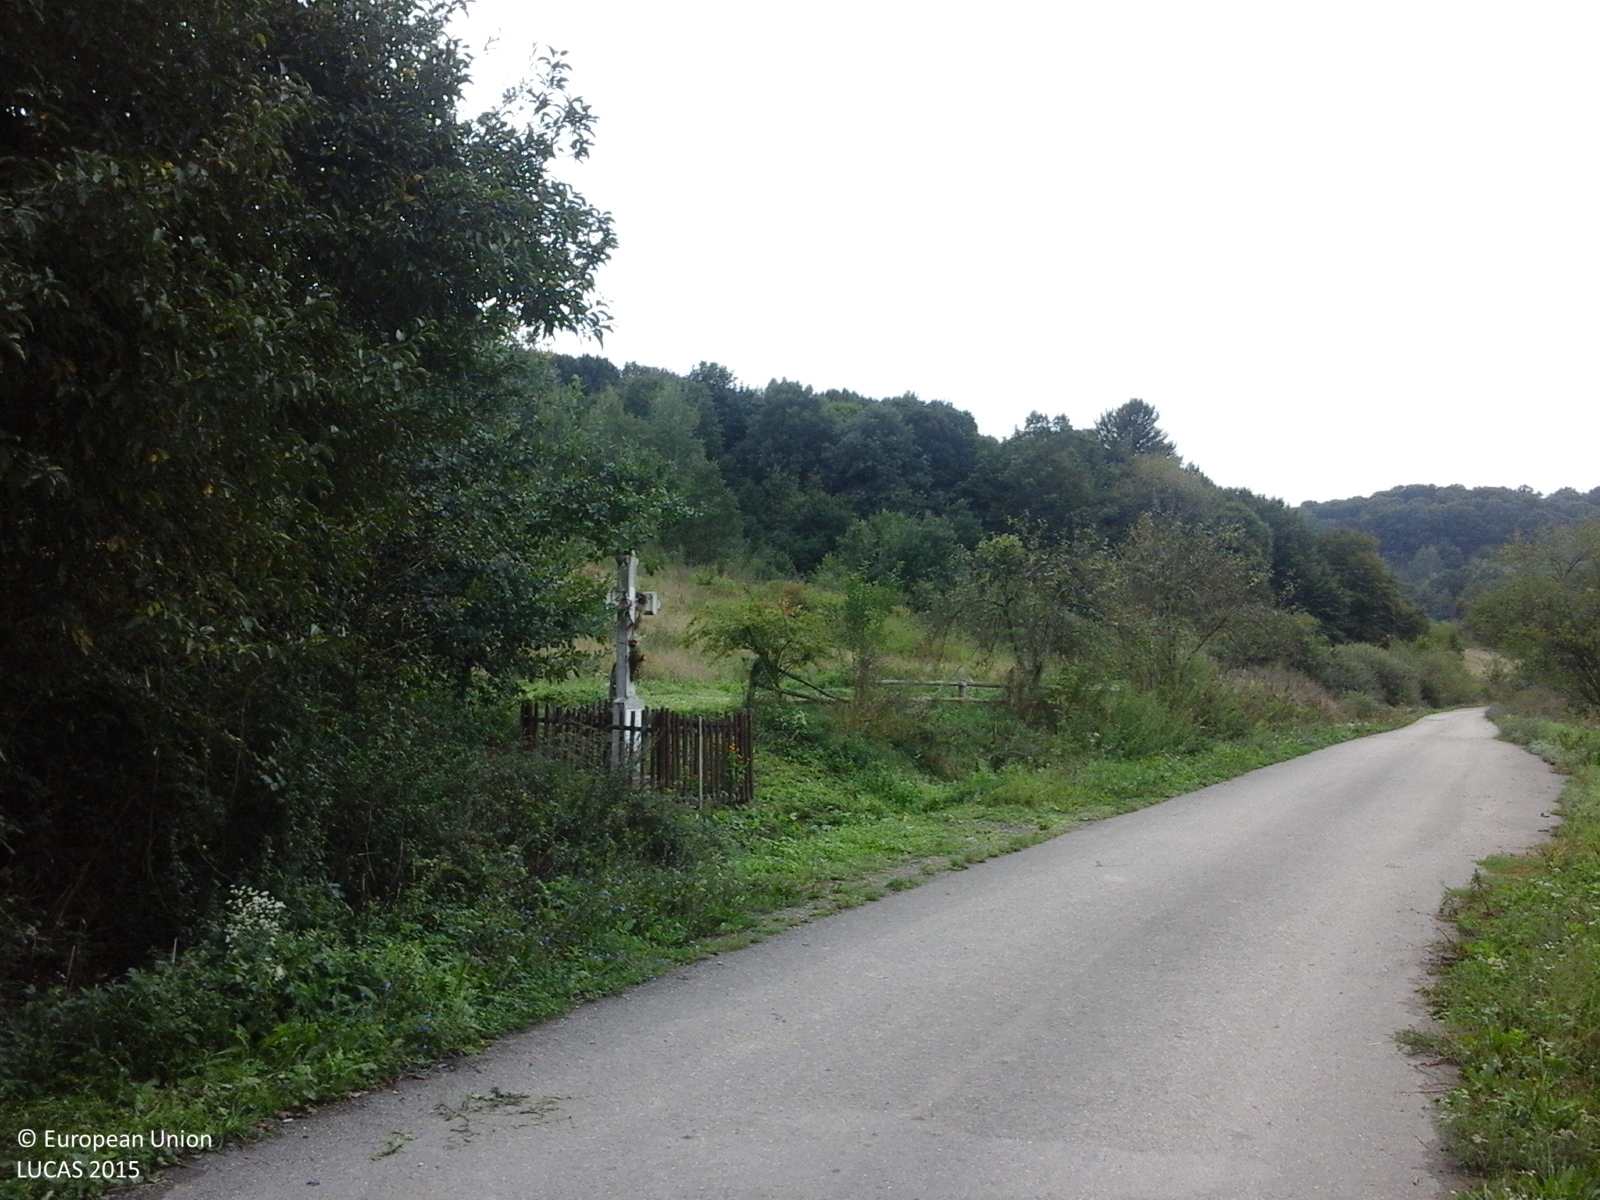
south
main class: Shrubland
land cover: Shrubland with sparse tree cover
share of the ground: > 75 %
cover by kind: shrubs 95 %, broadleaved forest trees 5 %
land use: Semi-natural and natural areas not in use
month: September
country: RO
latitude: 45.9138
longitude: 22.2797
